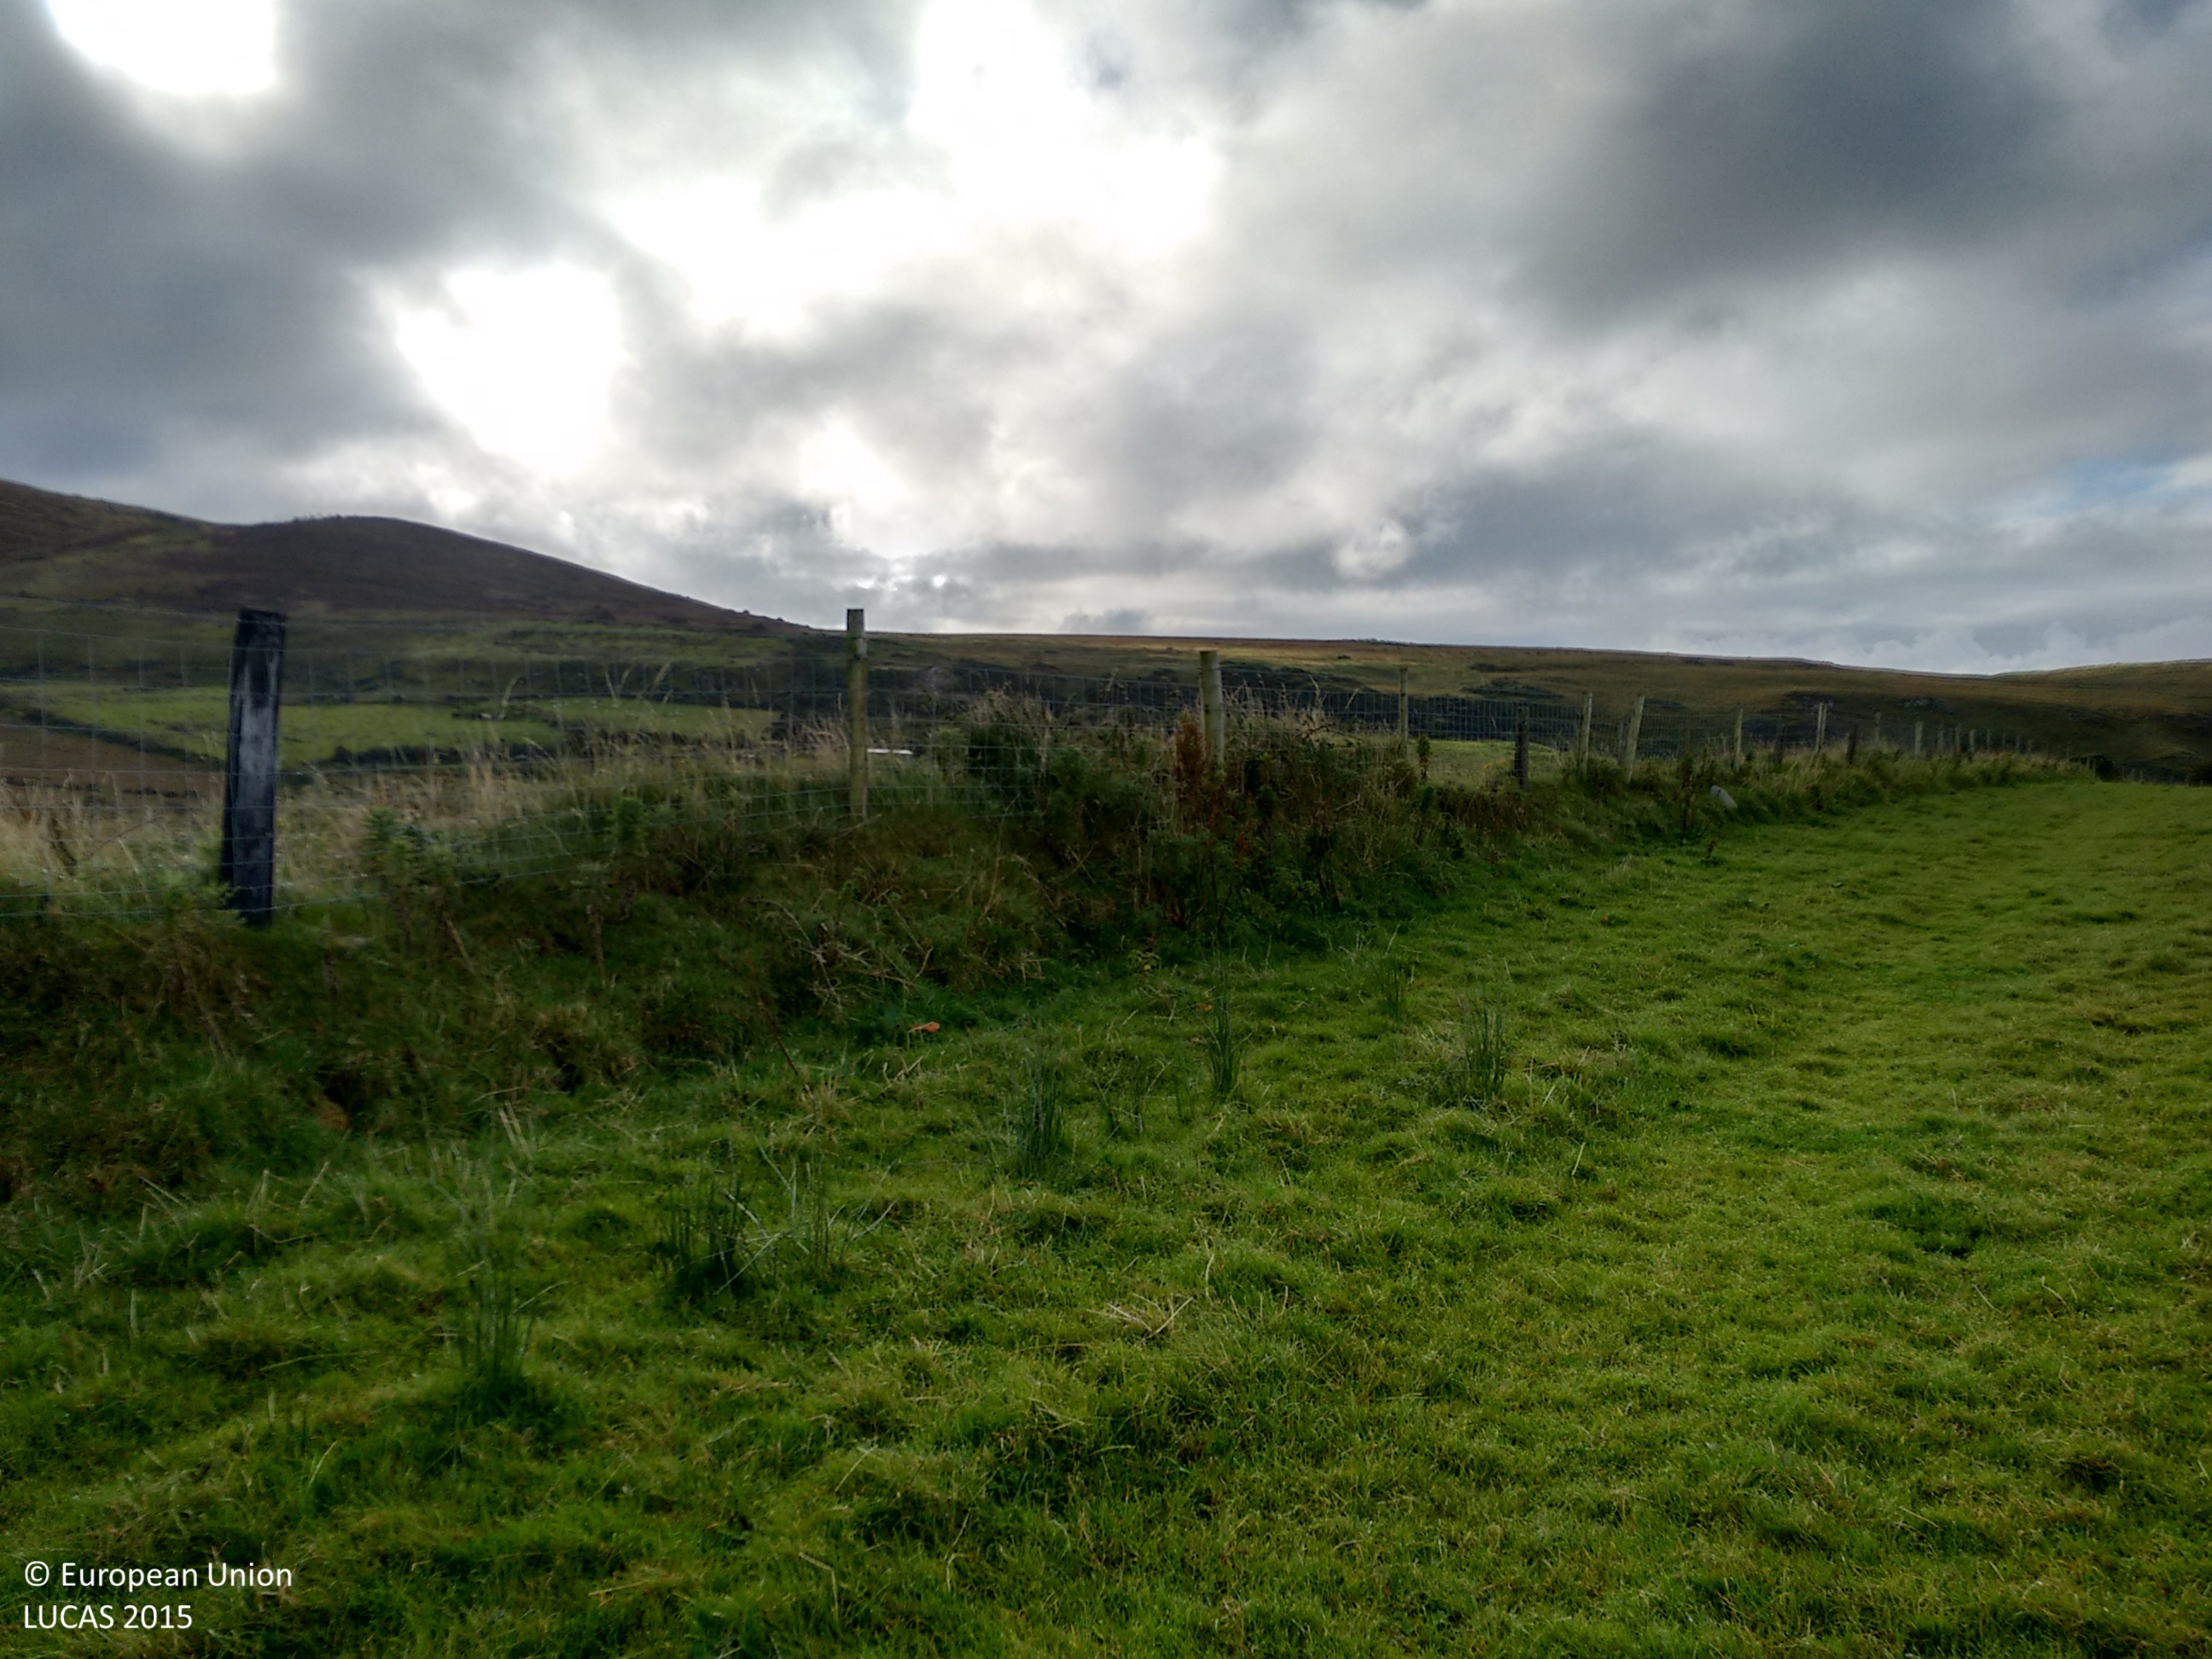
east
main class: Grassland
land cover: Grassland without tree/shrub cover
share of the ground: > 75 %
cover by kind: herbaceous plants 100 %
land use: Agriculture (excluding fallow land and kitchen gardens)
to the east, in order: Grassland without tree/shrub cover; Fences; Shruby margins; Grassland without tree/shrub cover; Fences; Grassland without tree/shrub cover; Fences; Managed hedges; Paved roads, cycling and walking lanes; Grass margins; Fences; Broadleaved woodland; Spontaneously vegetated surfaces; Electric lines; Spontaneously vegetated surfaces; Ditches and canals; Spontaneously vegetated surfaces
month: September
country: IE
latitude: 55.3290
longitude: -7.3118
